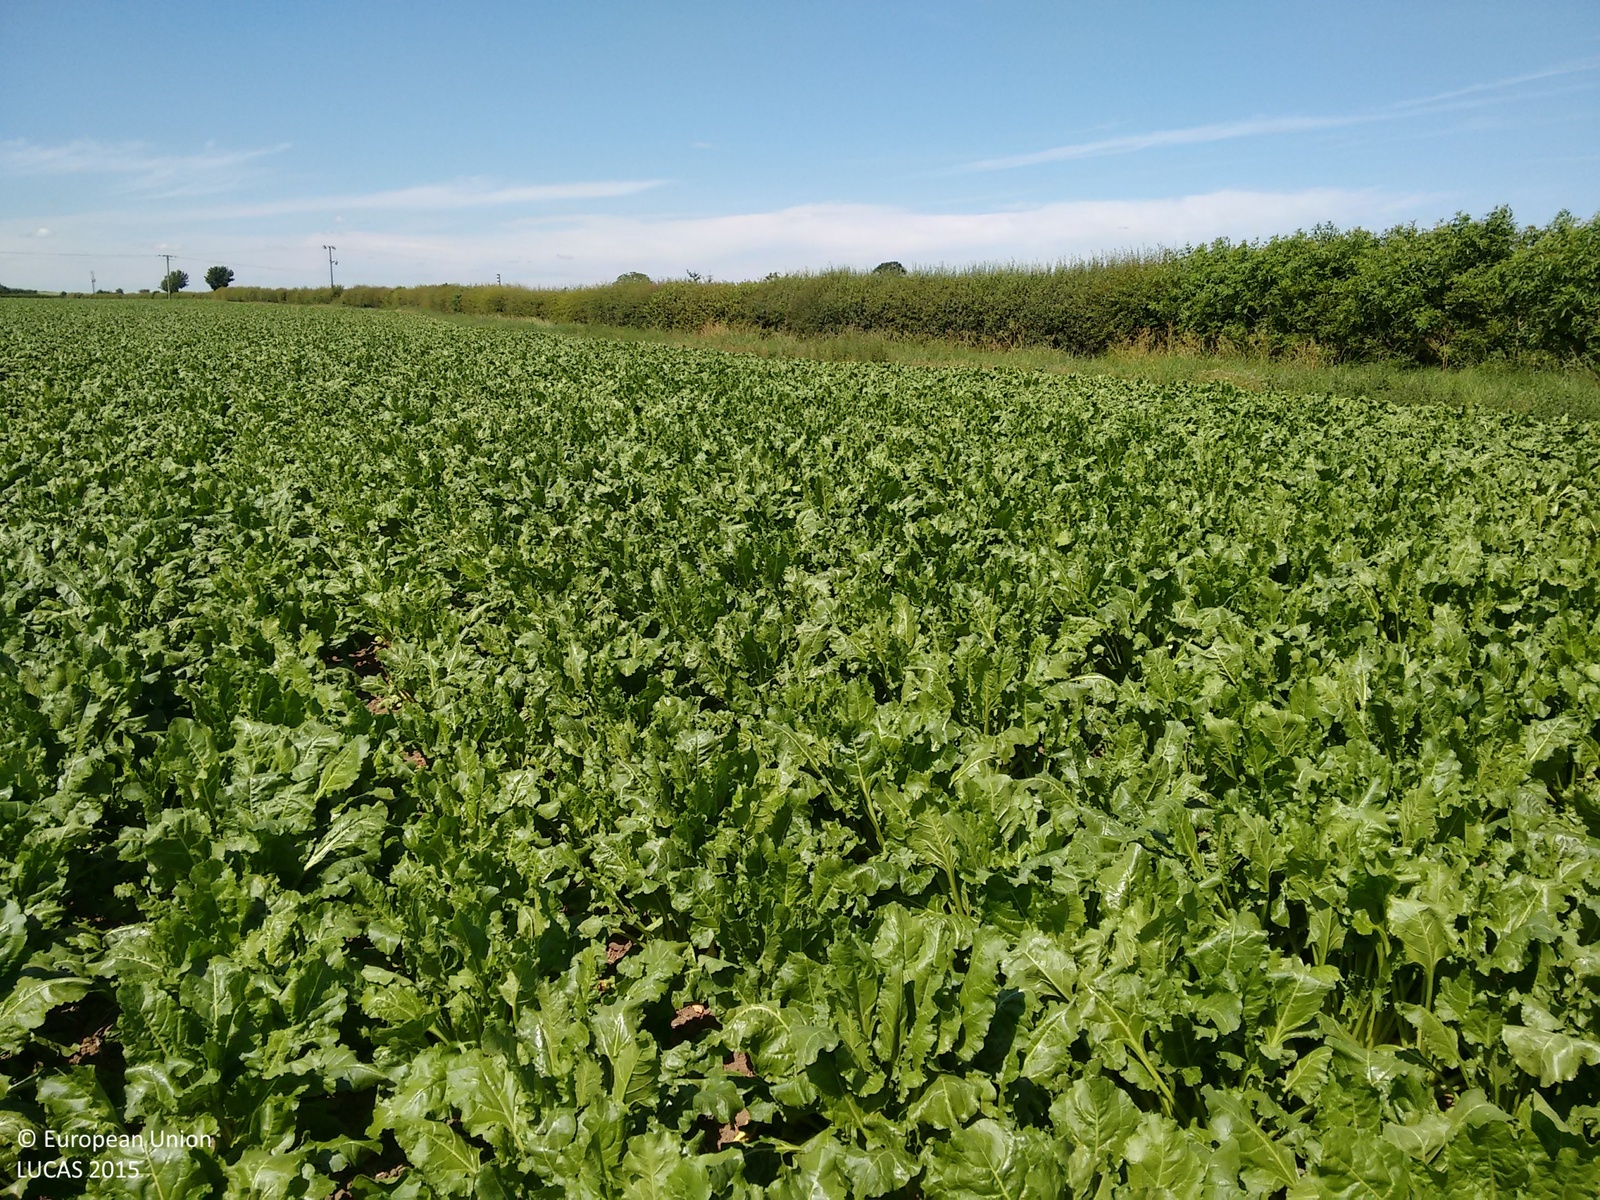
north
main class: Cropland
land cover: Sugar beet
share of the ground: > 75 %
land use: Agriculture (excluding fallow land and kitchen gardens)
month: July
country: GB
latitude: 52.9373
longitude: -0.9797
